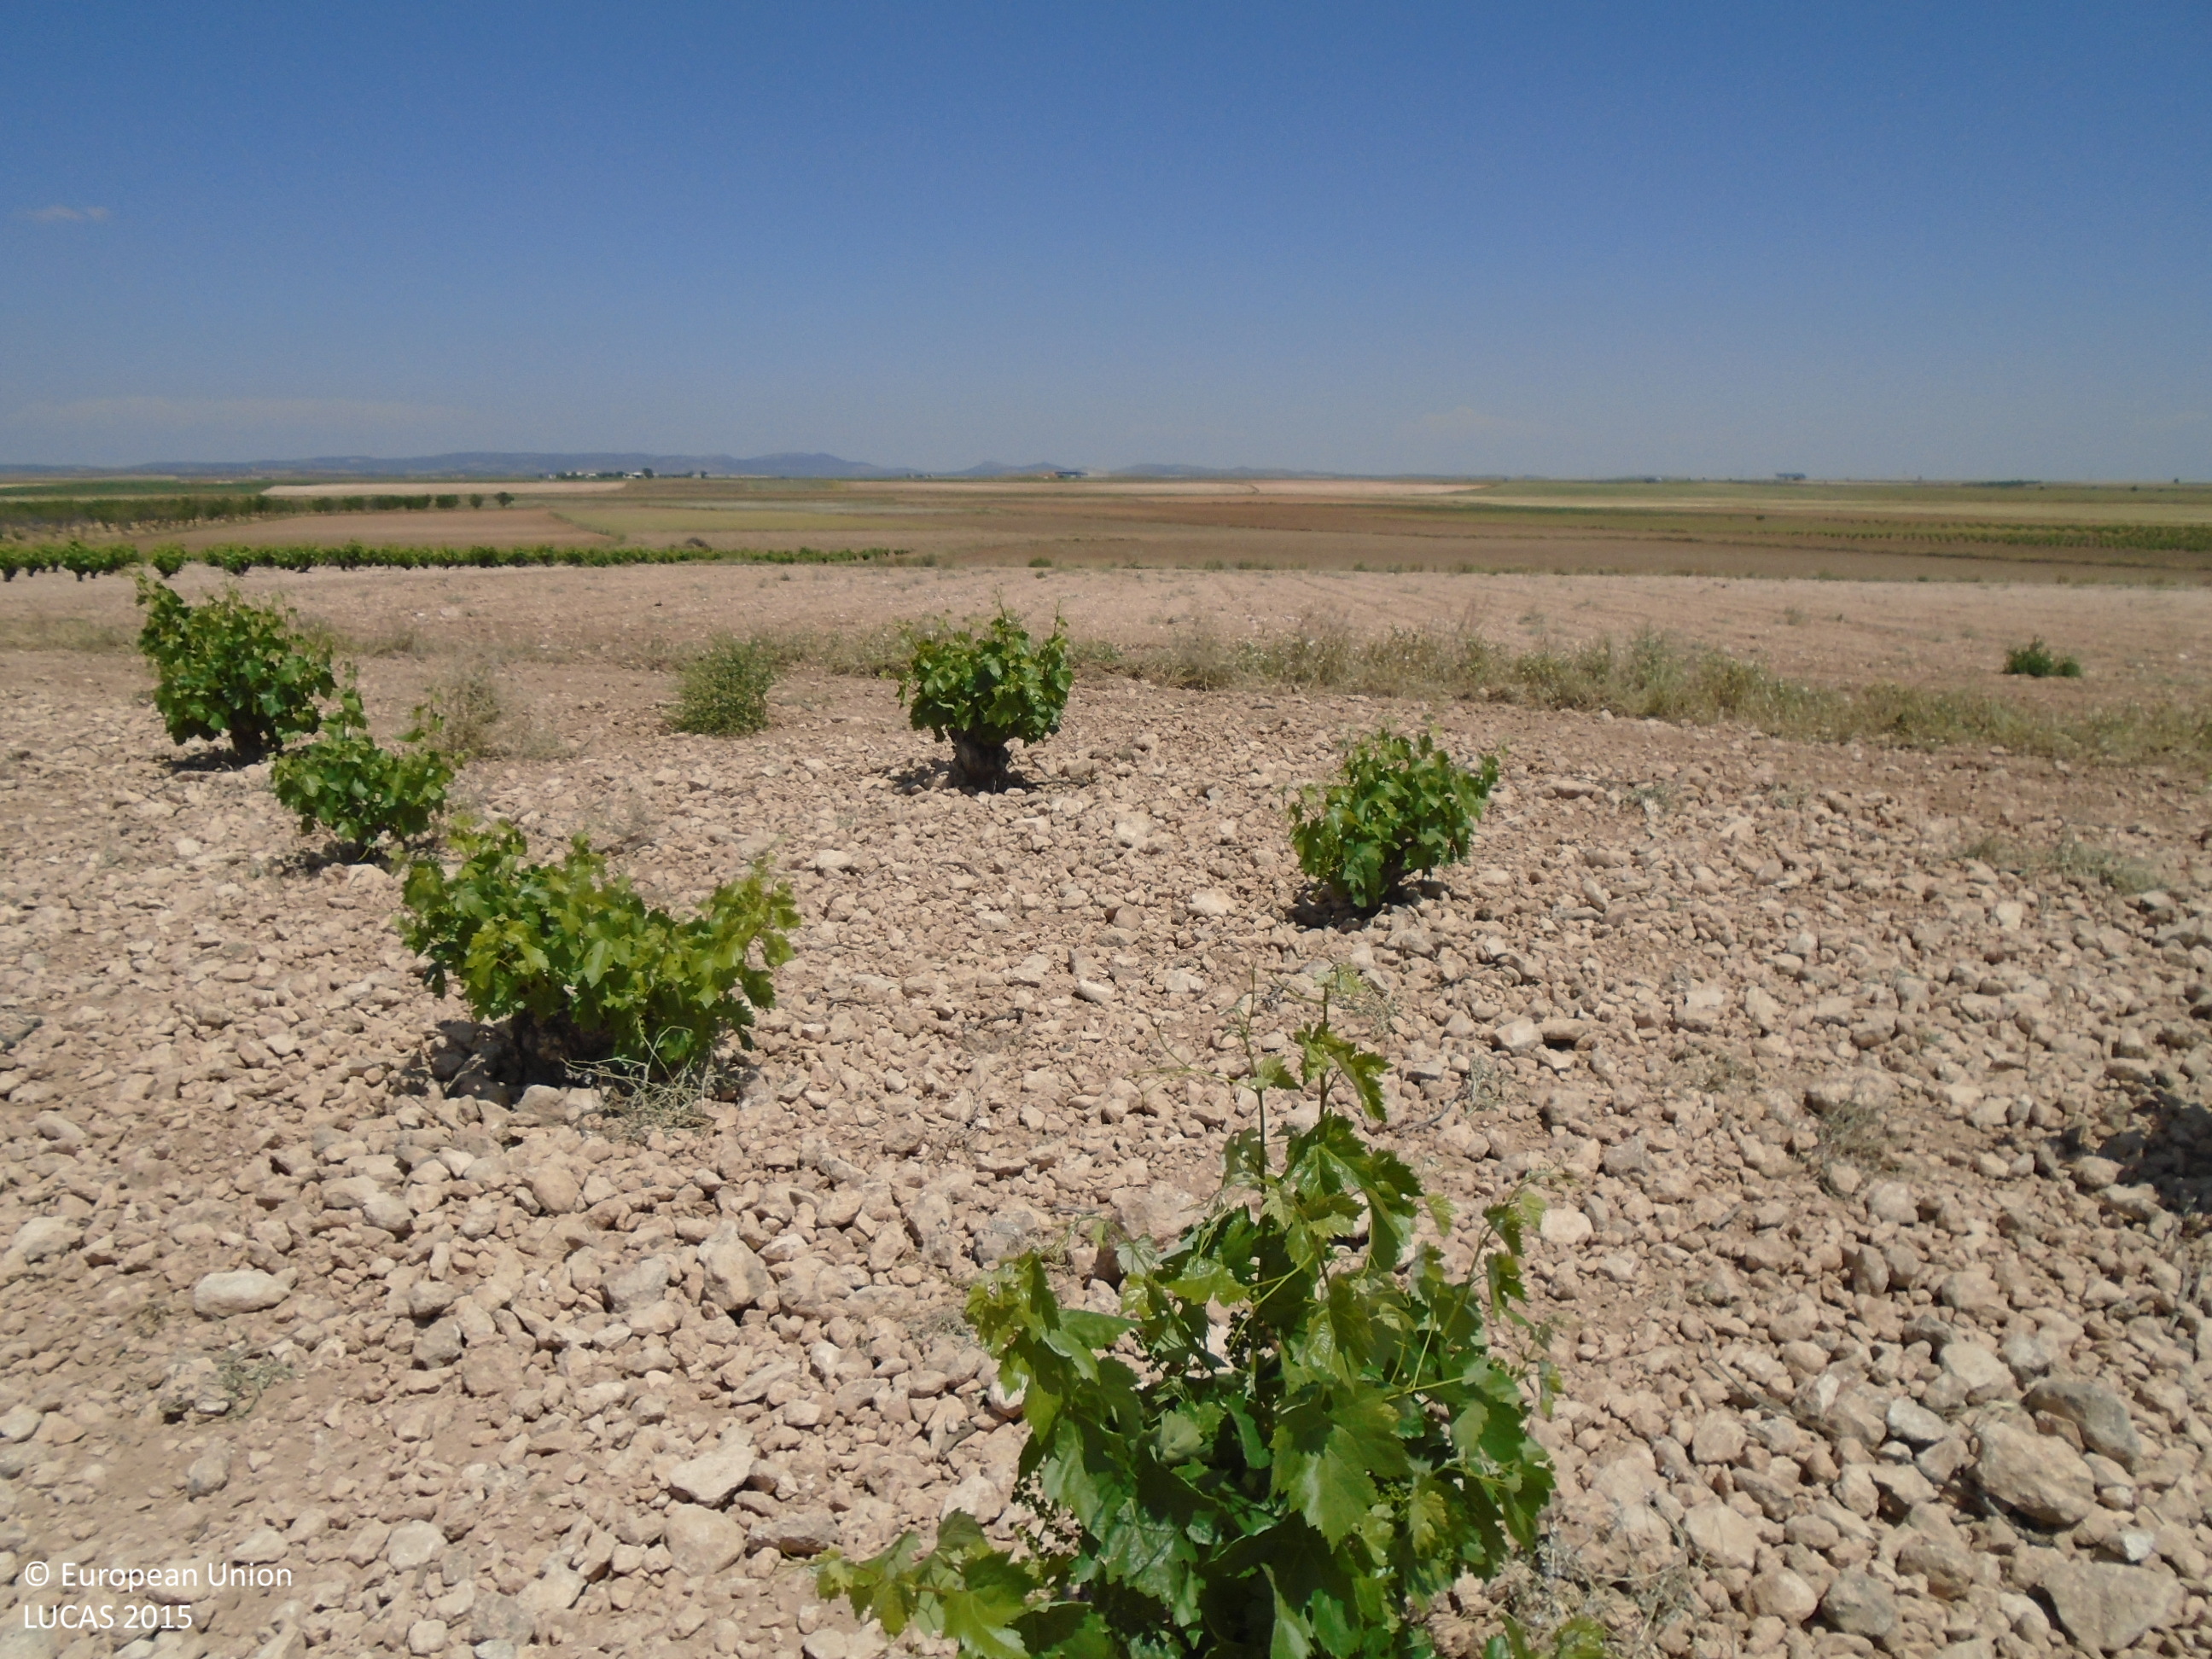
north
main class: Cropland
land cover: Vineyards
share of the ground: 10 - 25 %
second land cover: Other bare soil
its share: > 75 %
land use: Agriculture (excluding fallow land and kitchen gardens)
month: May
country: ES
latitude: 39.5253
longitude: -3.6708
